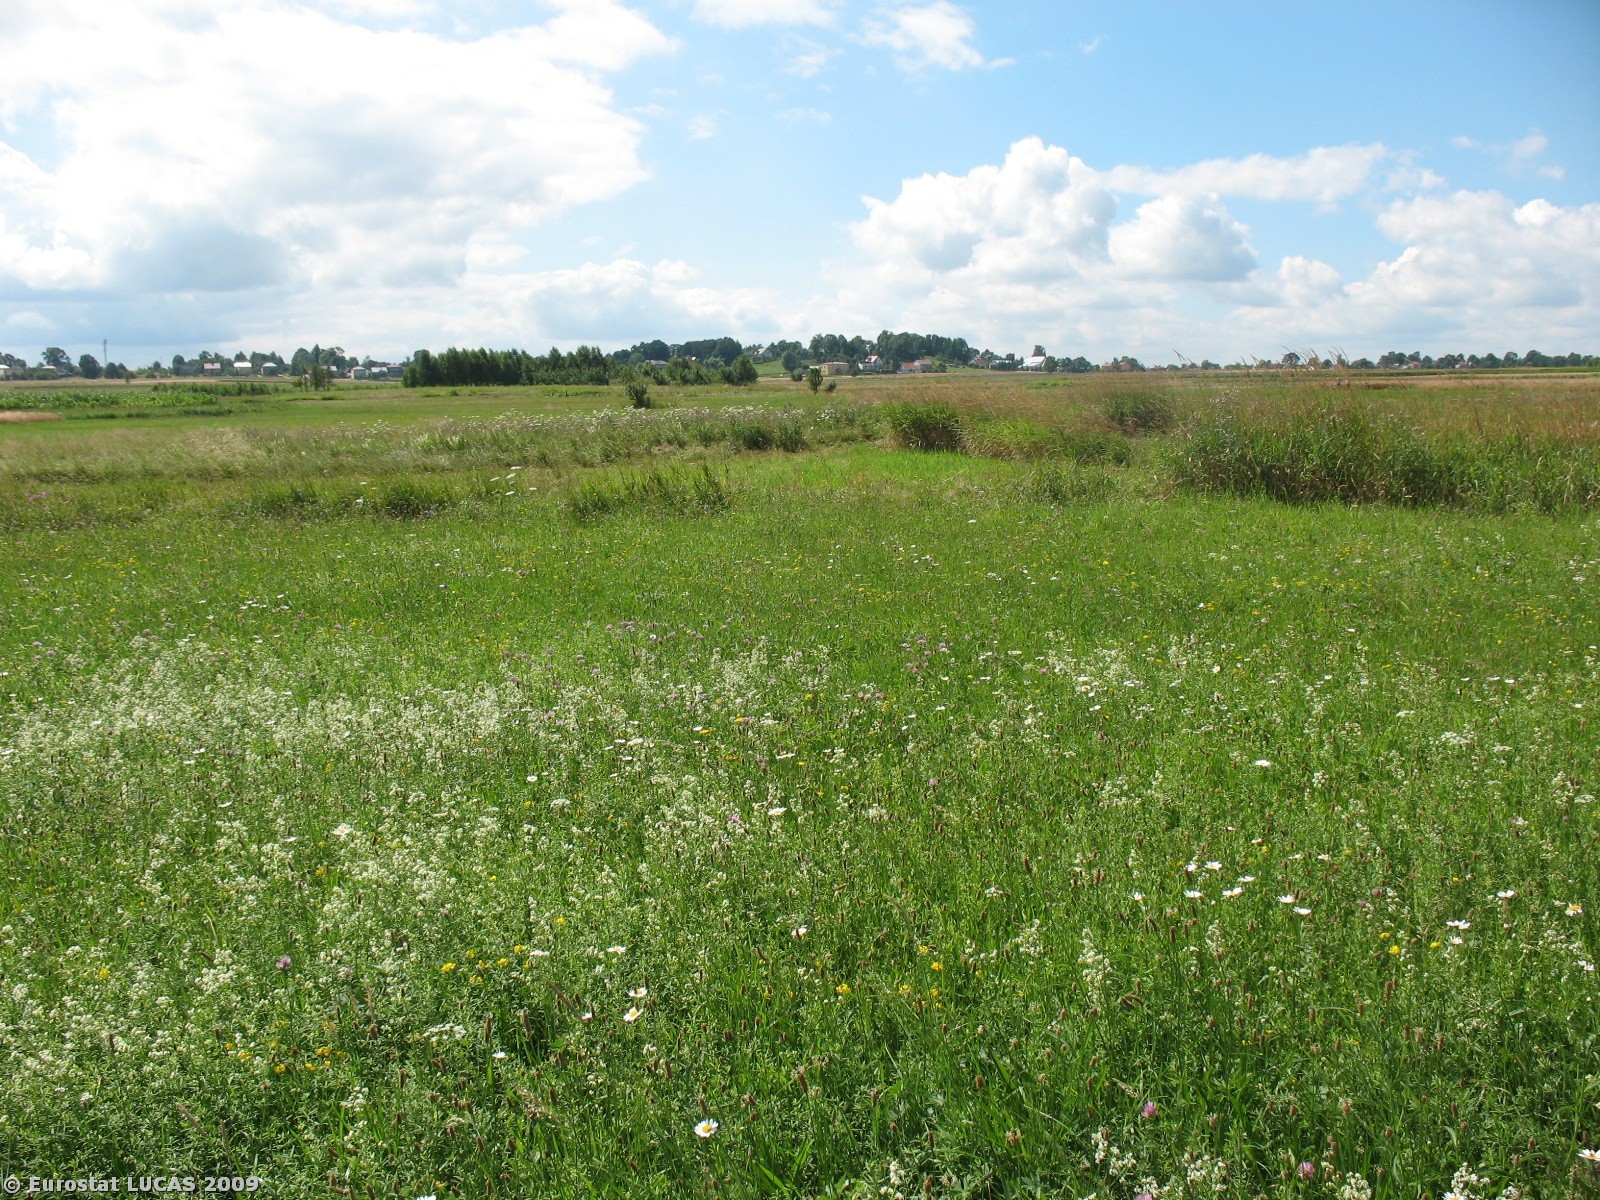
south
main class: Grassland
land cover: Grassland without tree/shrub cover
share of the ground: > 75 %
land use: Agriculture (excluding fallow land and kitchen gardens)
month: July
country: PL
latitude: 50.3165
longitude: 22.1233
